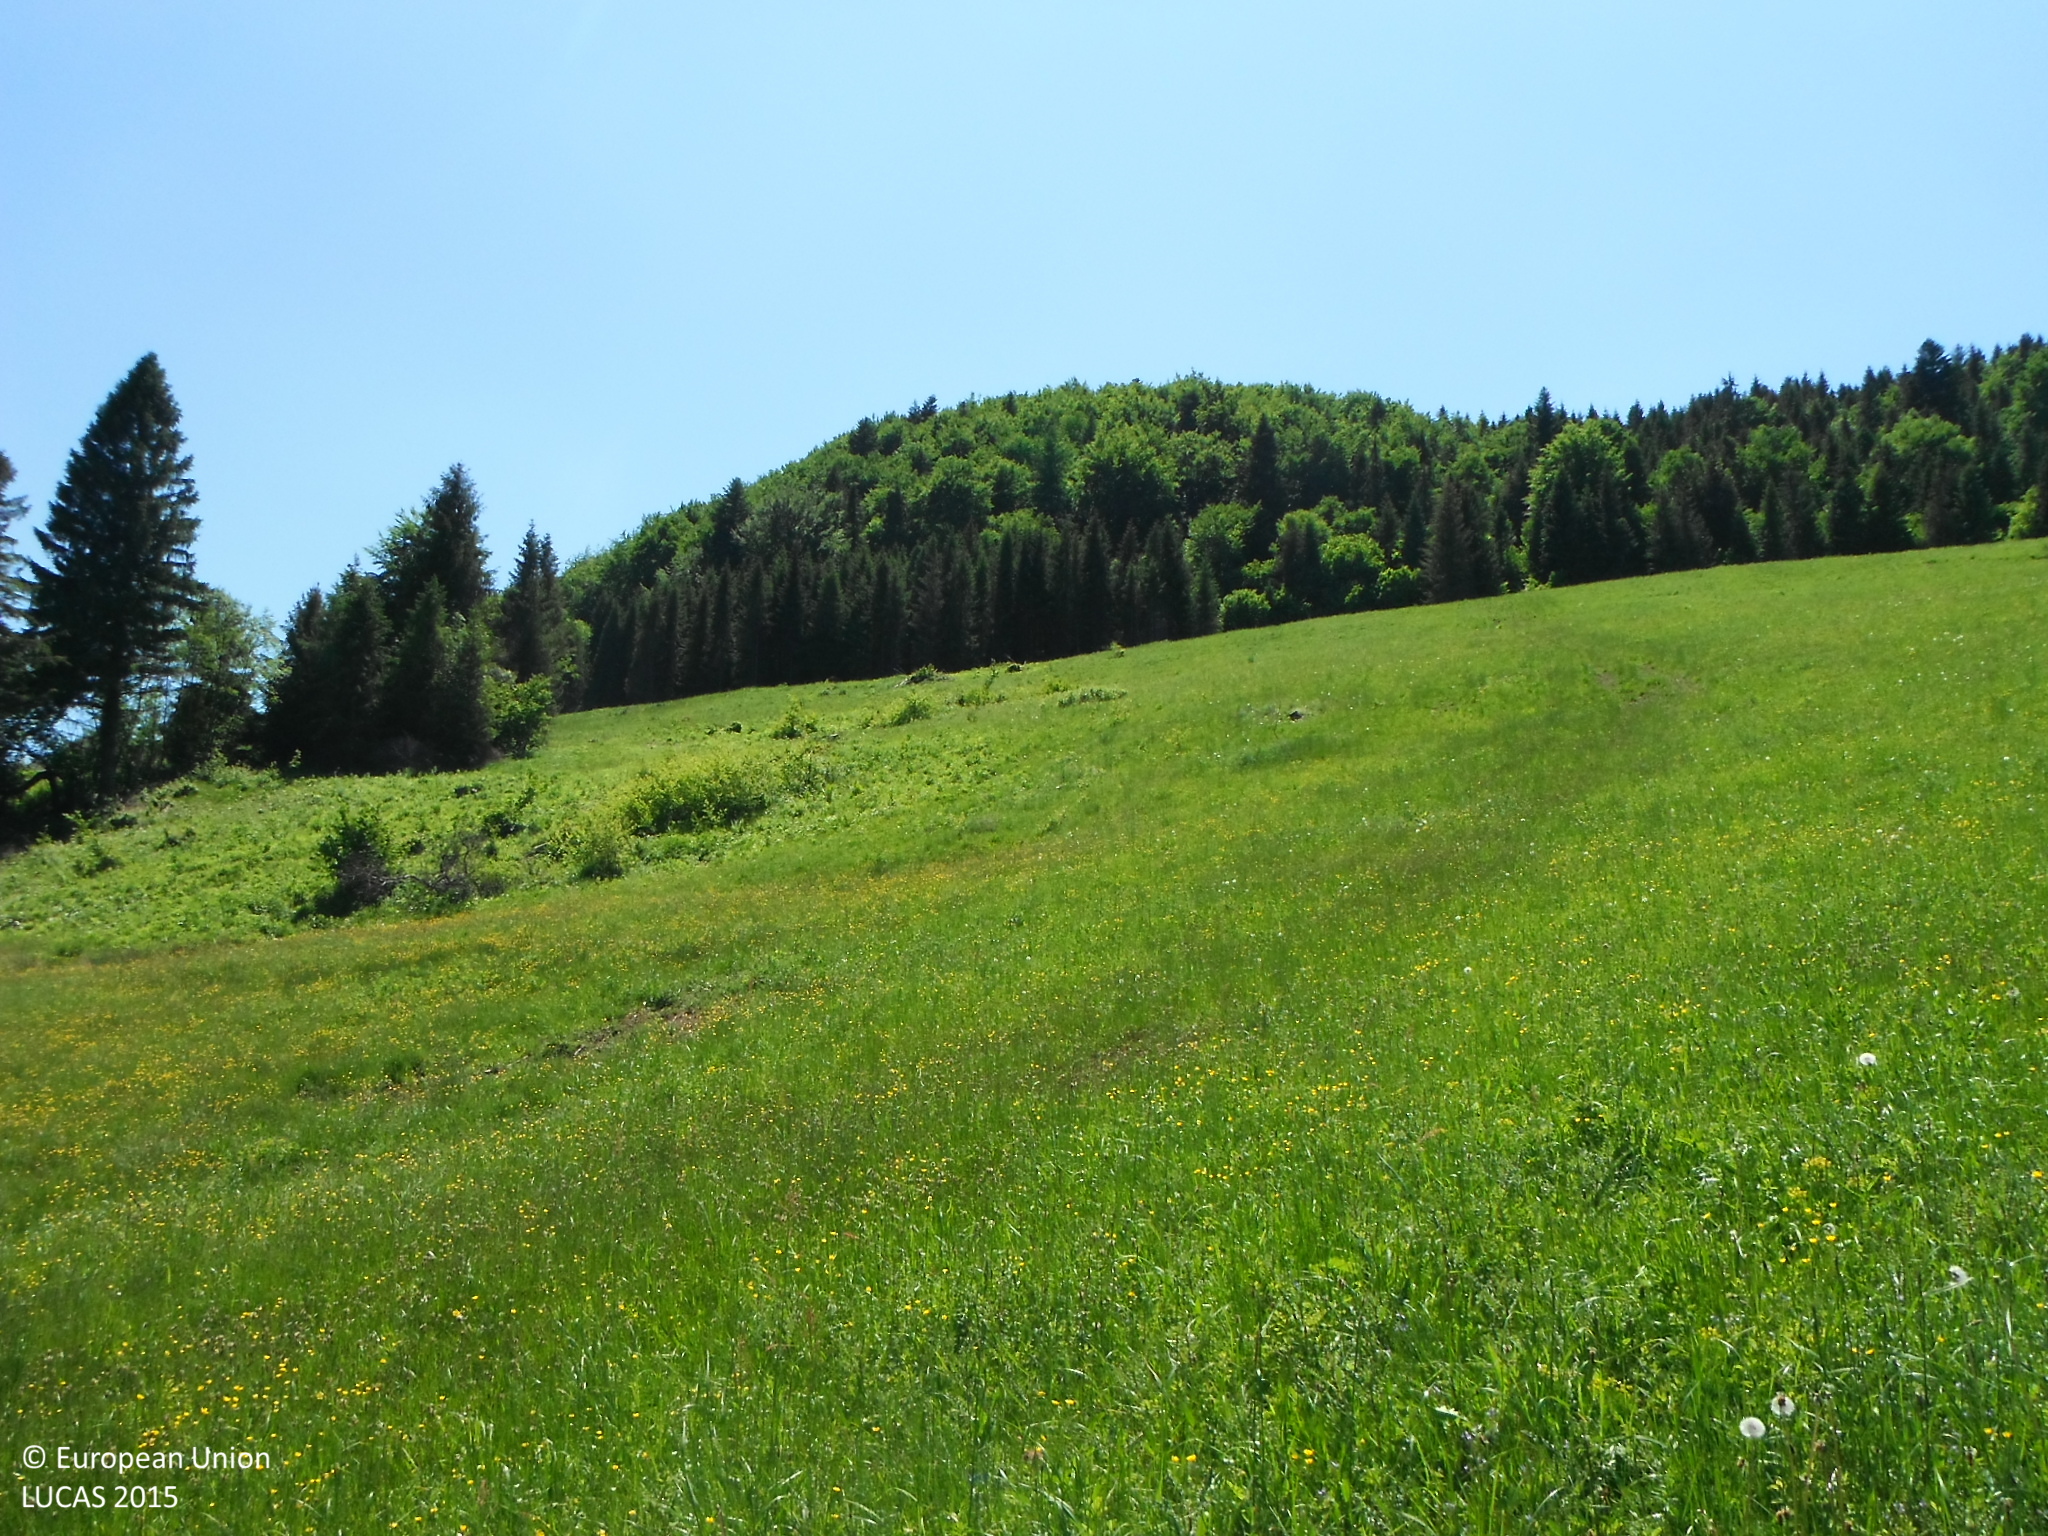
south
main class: Grassland
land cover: Grassland without tree/shrub cover
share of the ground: > 75 %
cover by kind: herbaceous plants 100 %
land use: Agriculture (excluding fallow land and kitchen gardens)
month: June
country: SK
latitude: 49.2400
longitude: 20.7389
